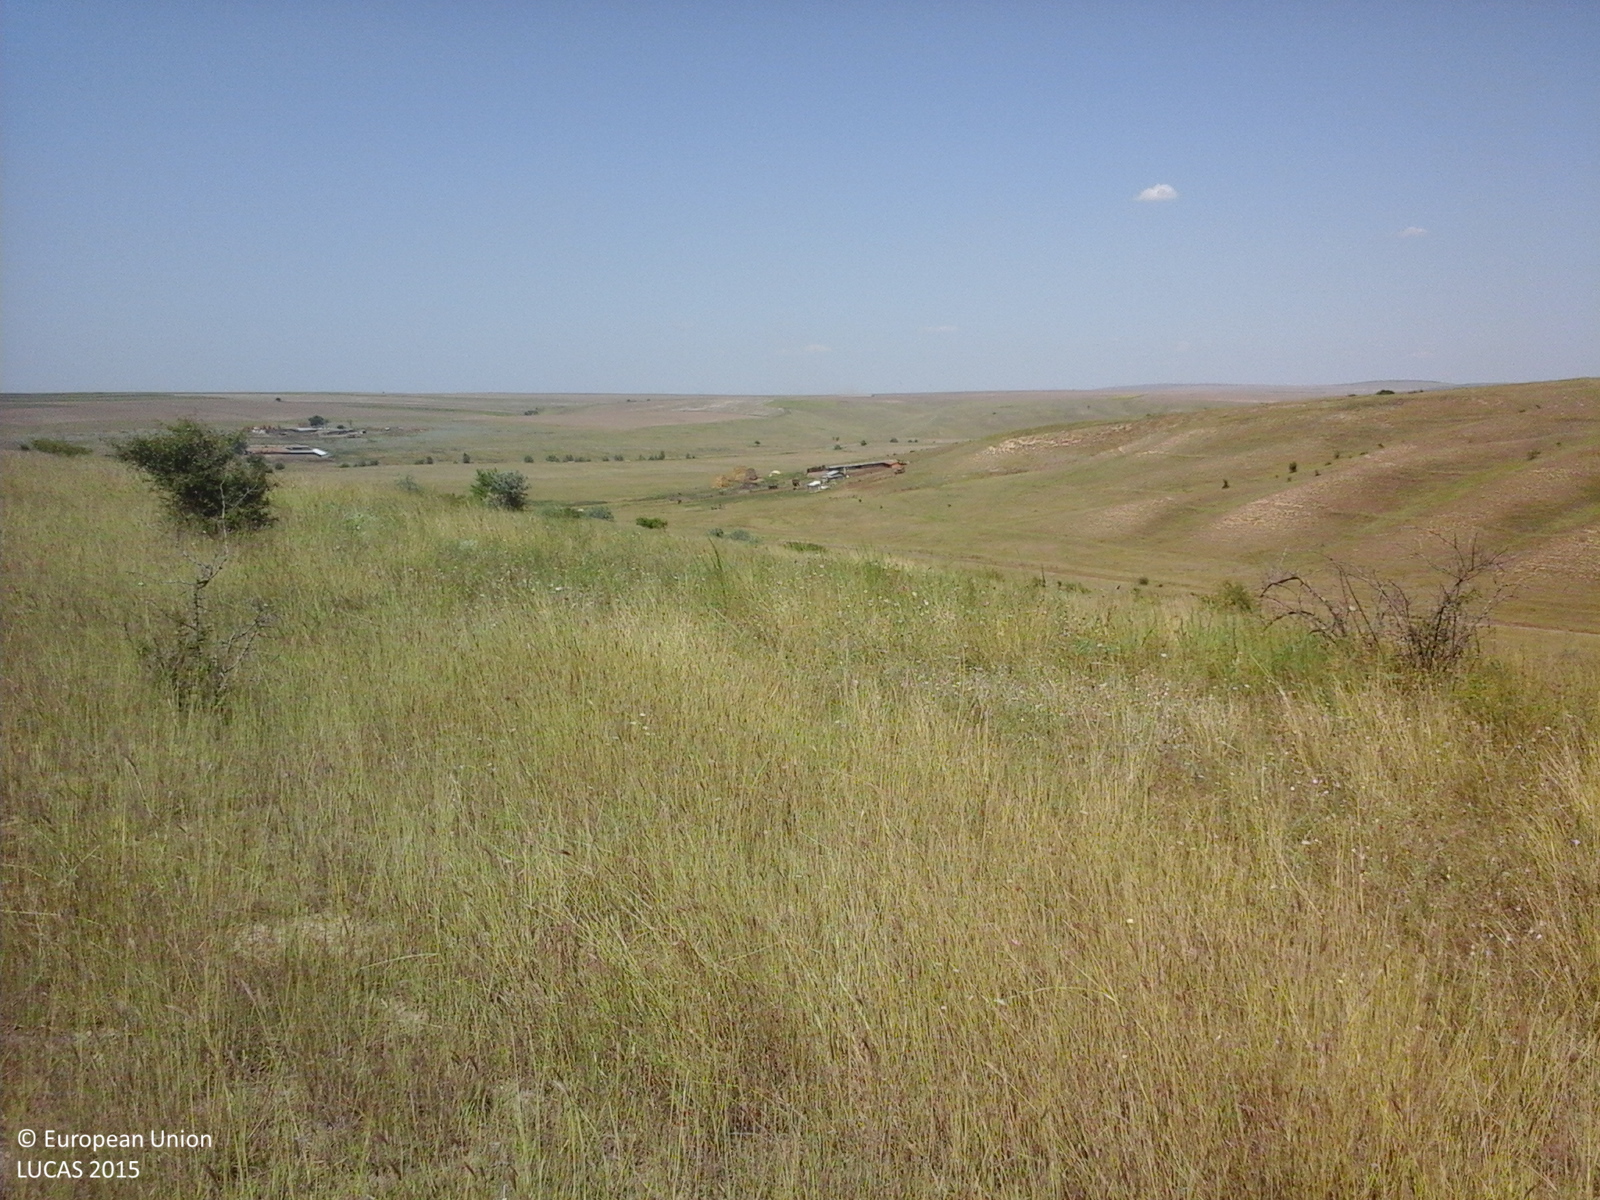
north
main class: Grassland
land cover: Grassland without tree/shrub cover
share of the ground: > 75 %
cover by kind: herbaceous plants 100 %
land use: Agriculture (excluding fallow land and kitchen gardens)
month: August
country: RO
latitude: 44.4329
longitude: 28.1384
